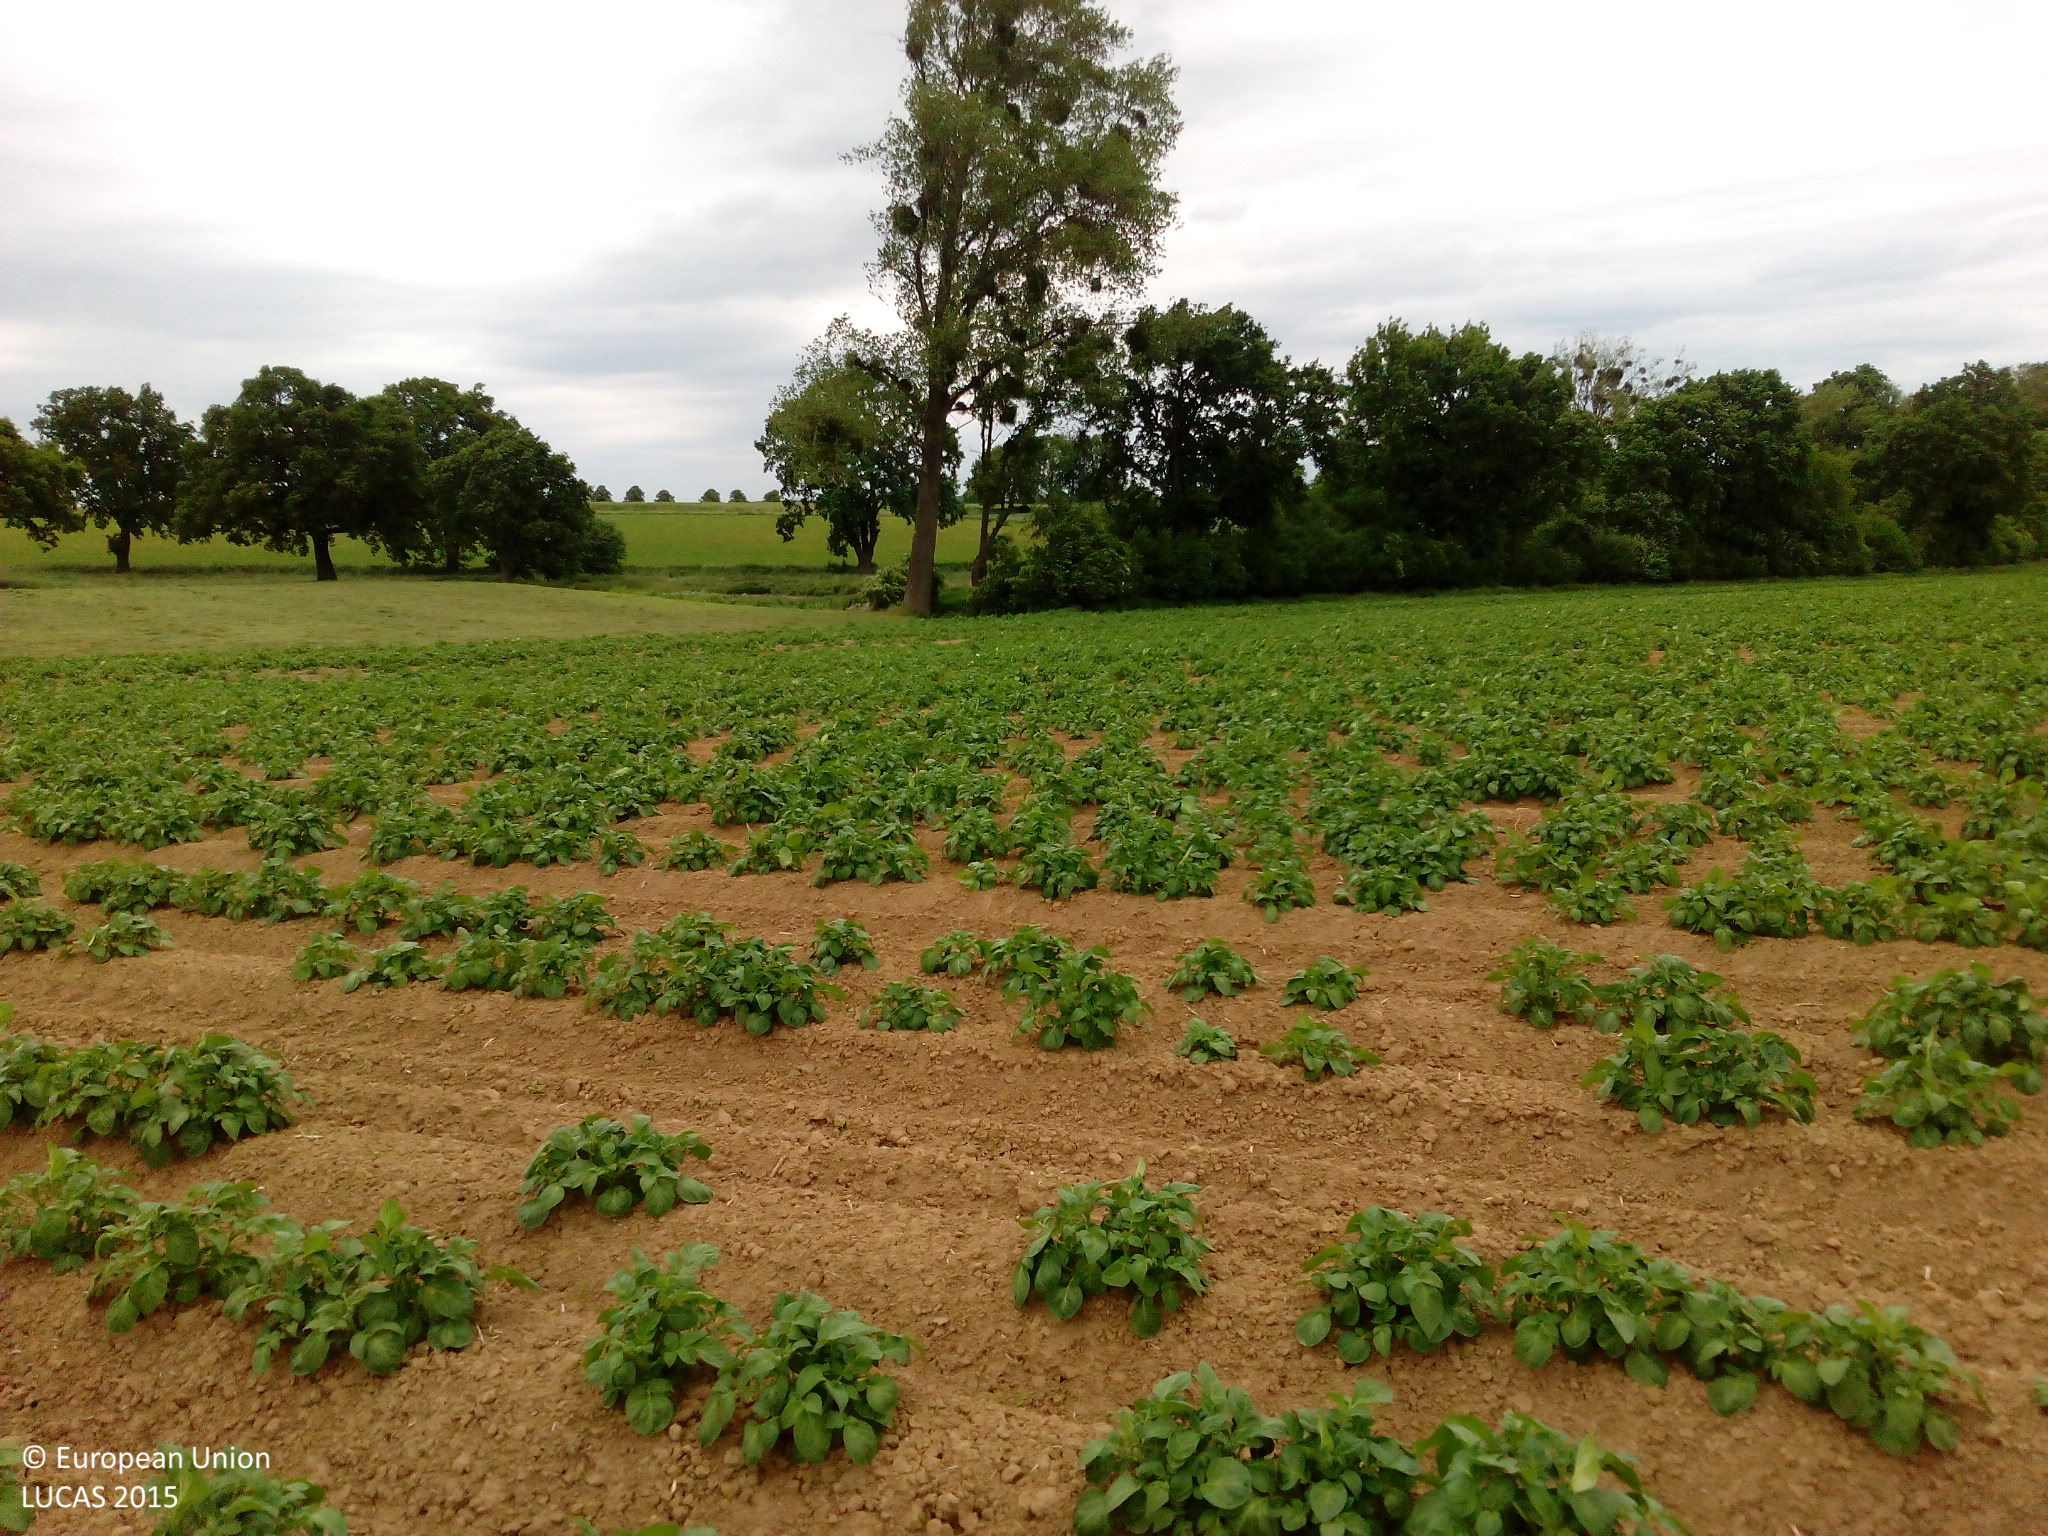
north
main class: Cropland
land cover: Potatoes
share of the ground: 10 - 25 %
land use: Agriculture (excluding fallow land and kitchen gardens)
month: June
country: DE
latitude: 51.5874
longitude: 7.9942
